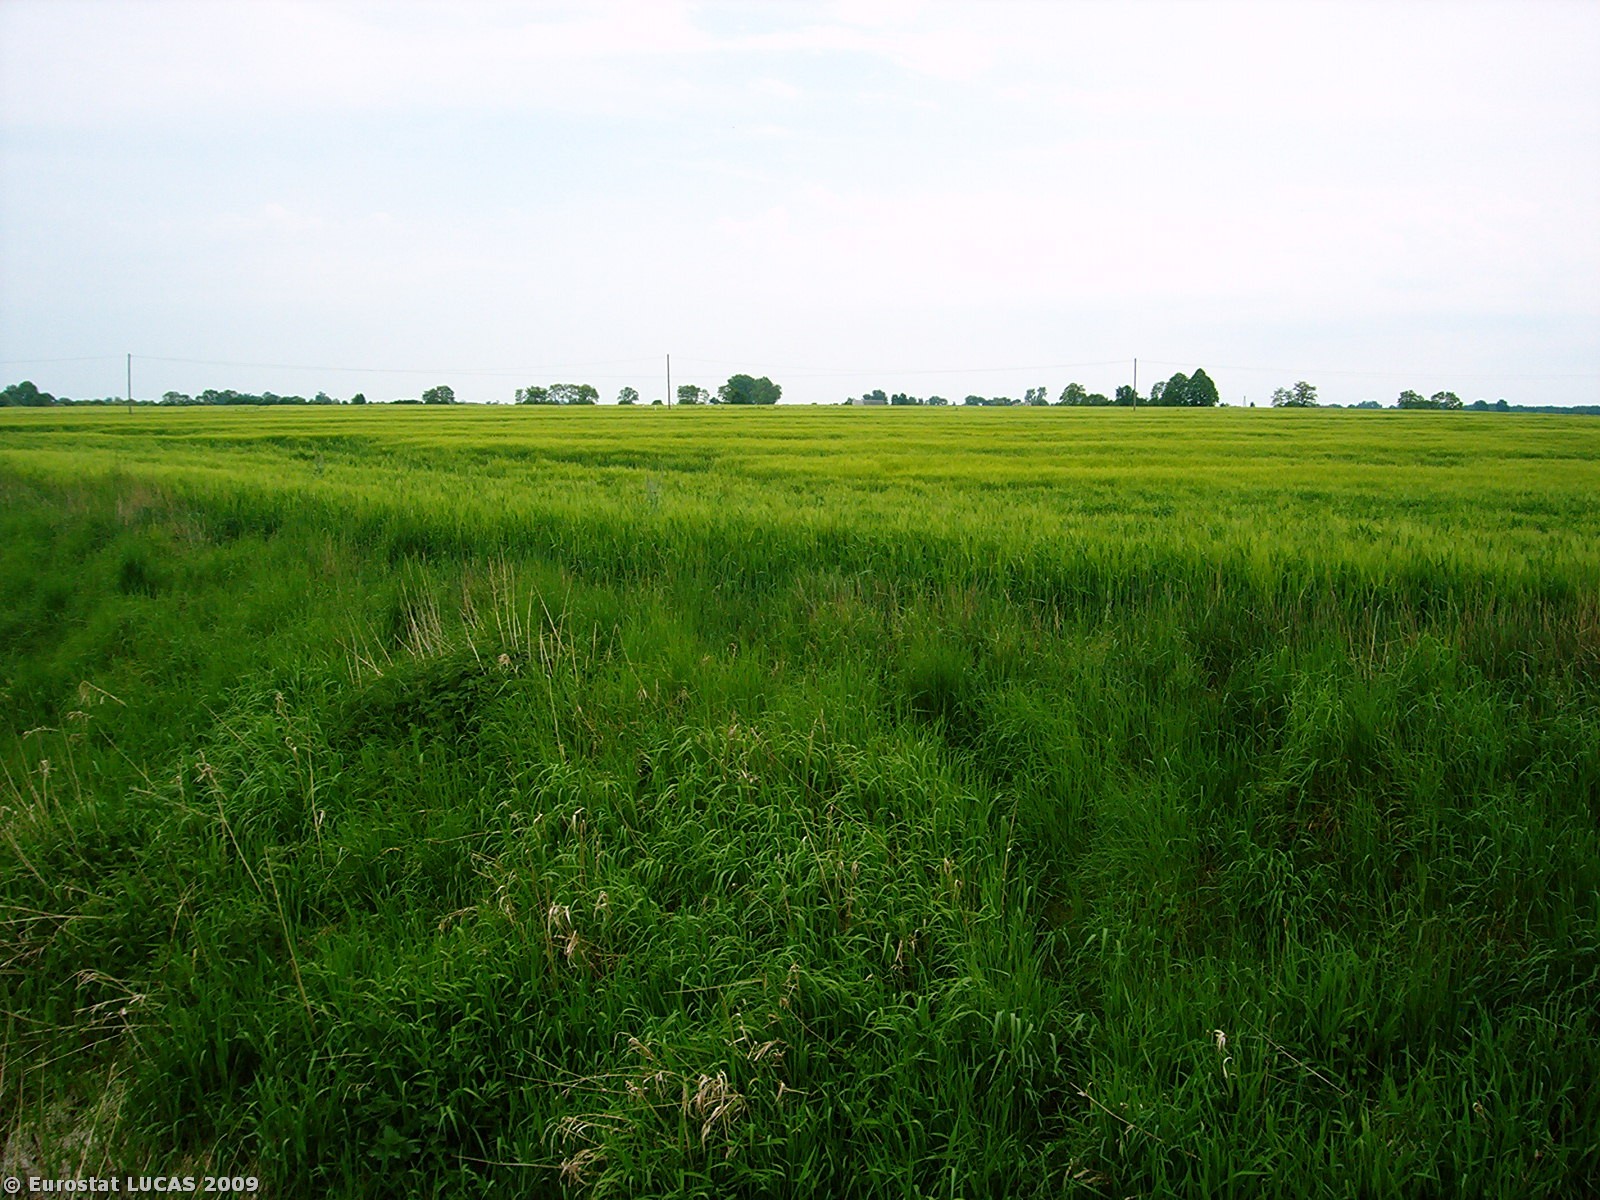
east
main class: Cropland
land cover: Rape and turnip rape
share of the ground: > 75 %
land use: Agriculture (excluding fallow land and kitchen gardens)
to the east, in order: Rape and turnip rape
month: May
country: PL
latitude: 52.6520
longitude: 16.4669
